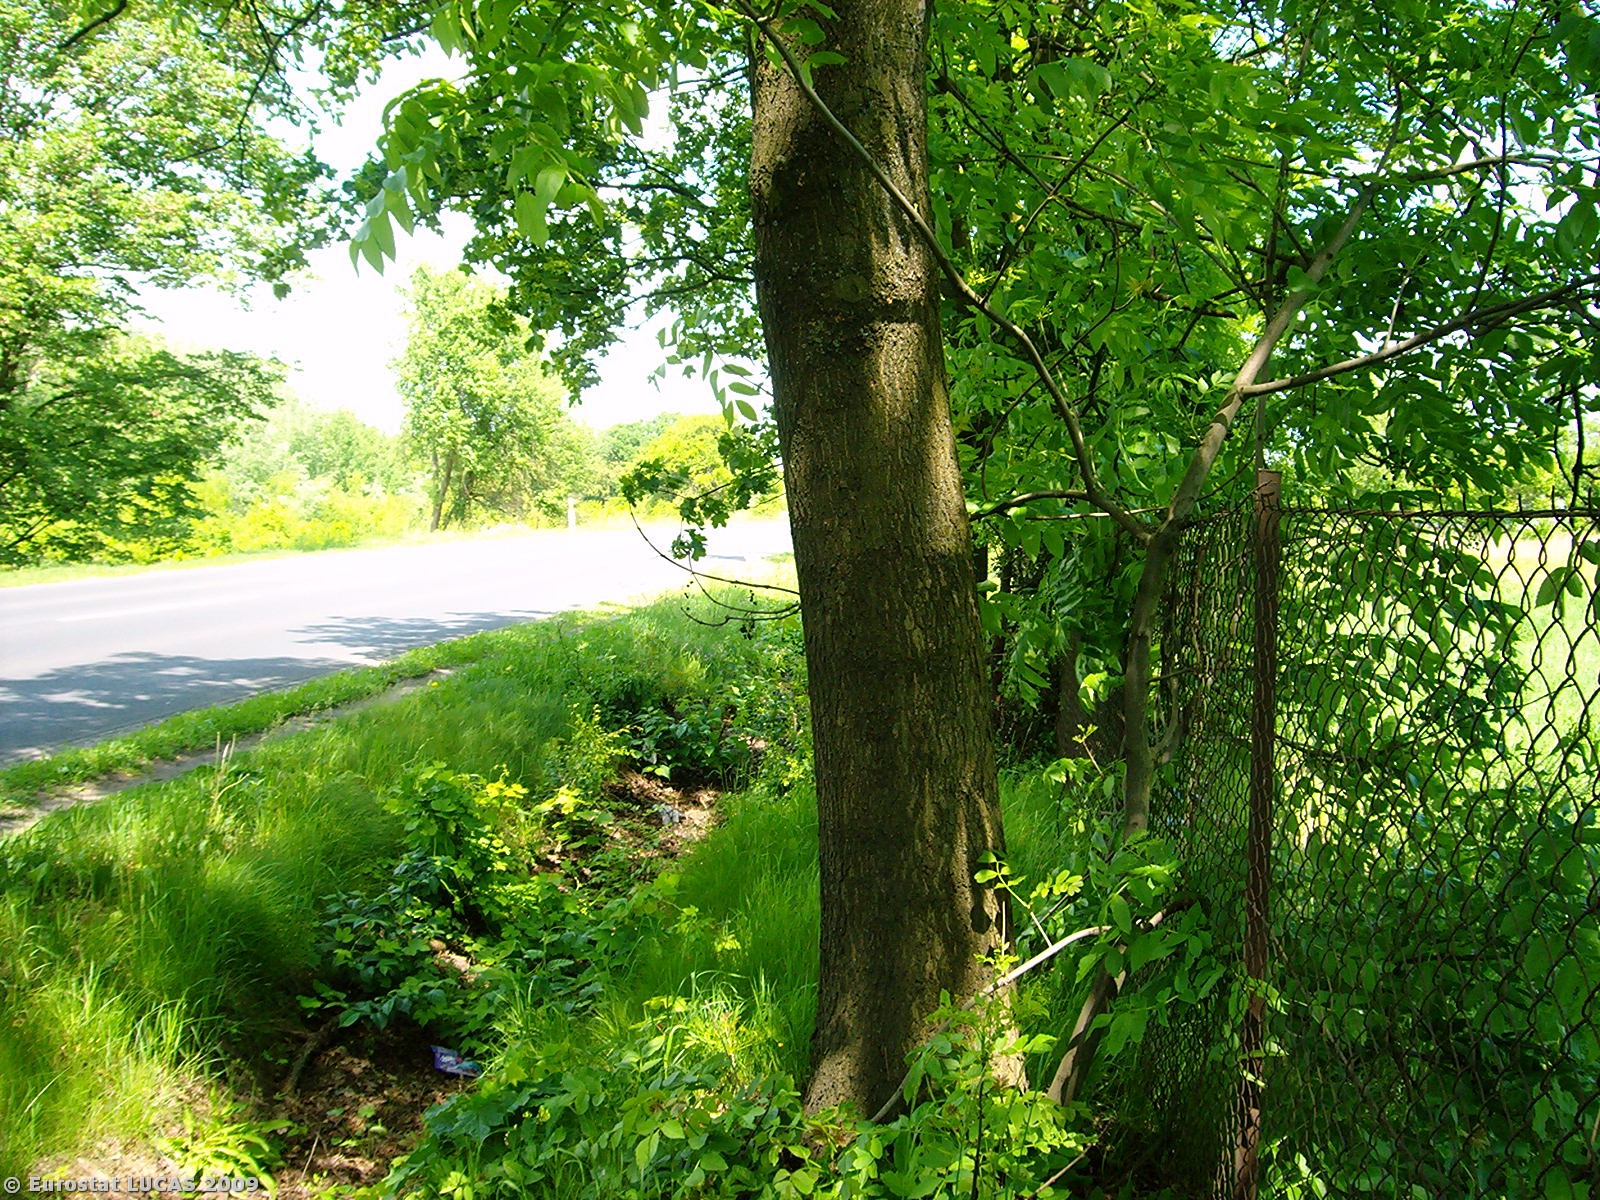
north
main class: Woodland
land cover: Broadleaved woodland
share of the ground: > 75 %
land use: Unused
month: May
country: PL
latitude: 52.4970
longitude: 16.9768
